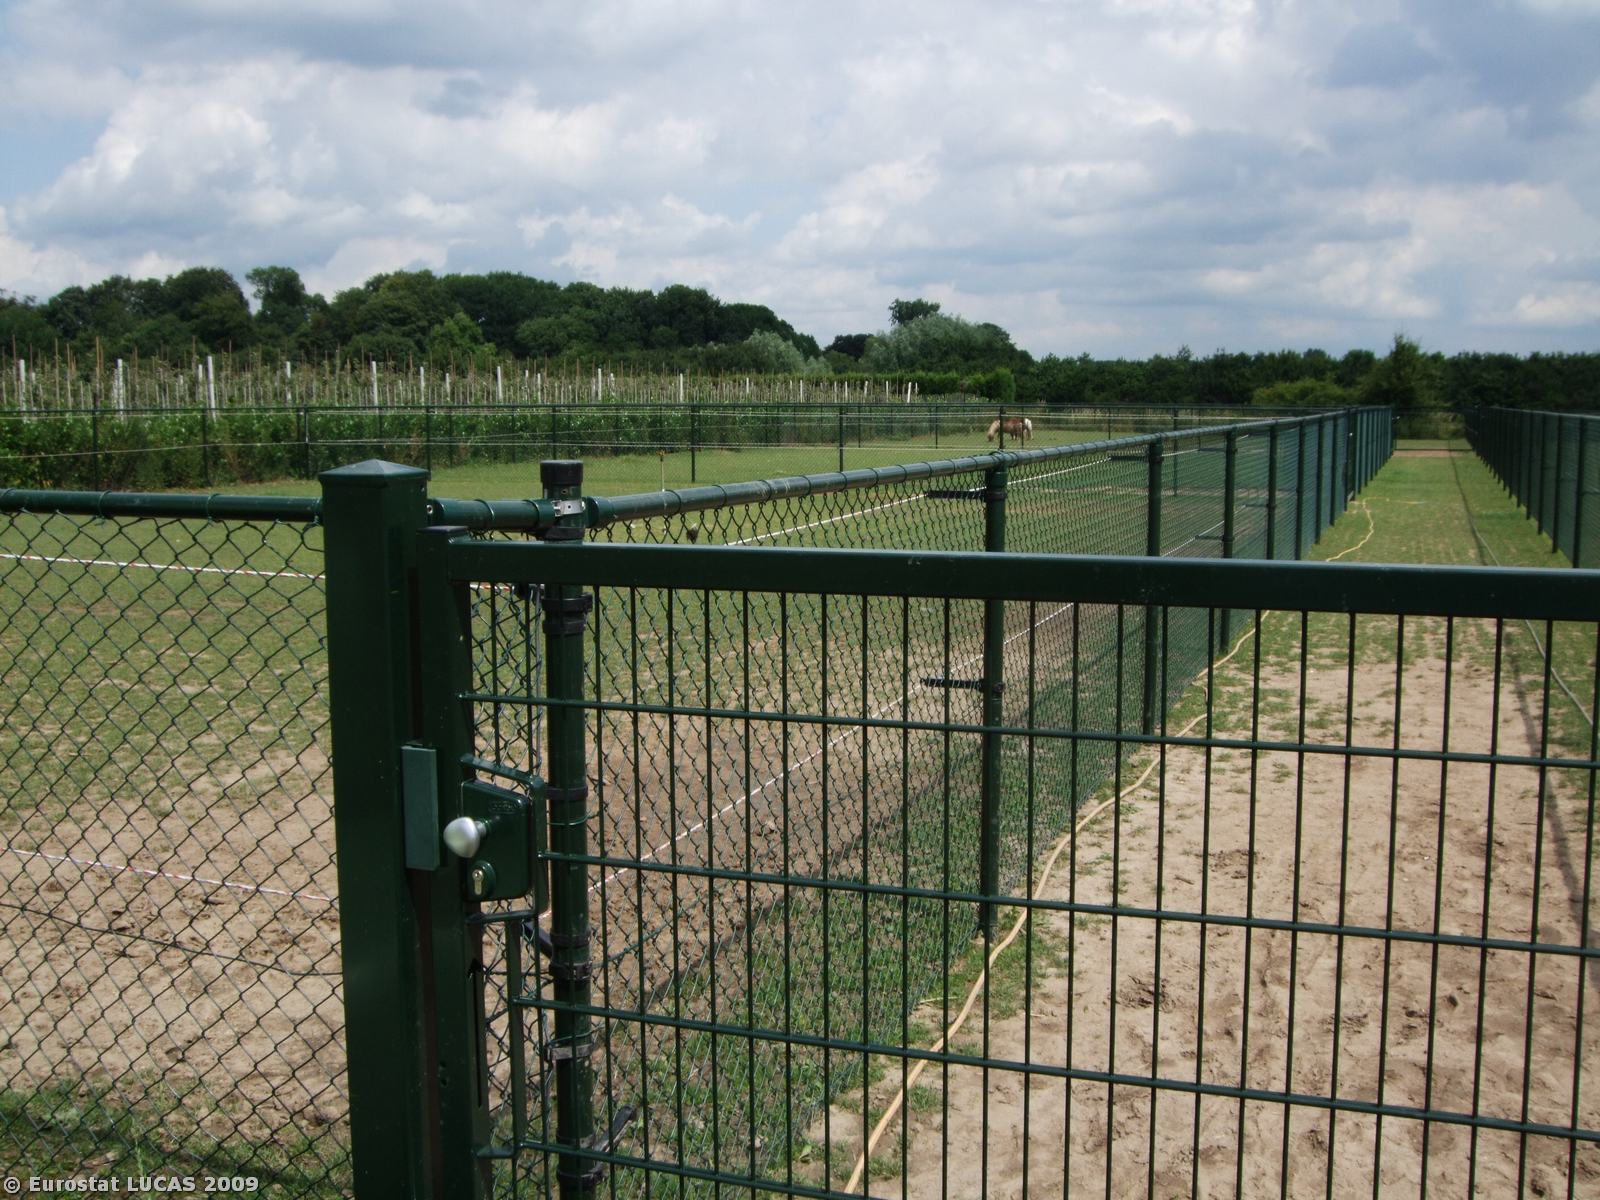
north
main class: Cropland
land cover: Apple fruit
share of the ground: 25 - 50 %
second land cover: Grassland with sparse tree/shrub cover
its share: 50 - 75 %
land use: Agriculture (excluding fallow land and kitchen gardens)
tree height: < 5 m
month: July
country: NL
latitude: 51.9110
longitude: 5.4190
